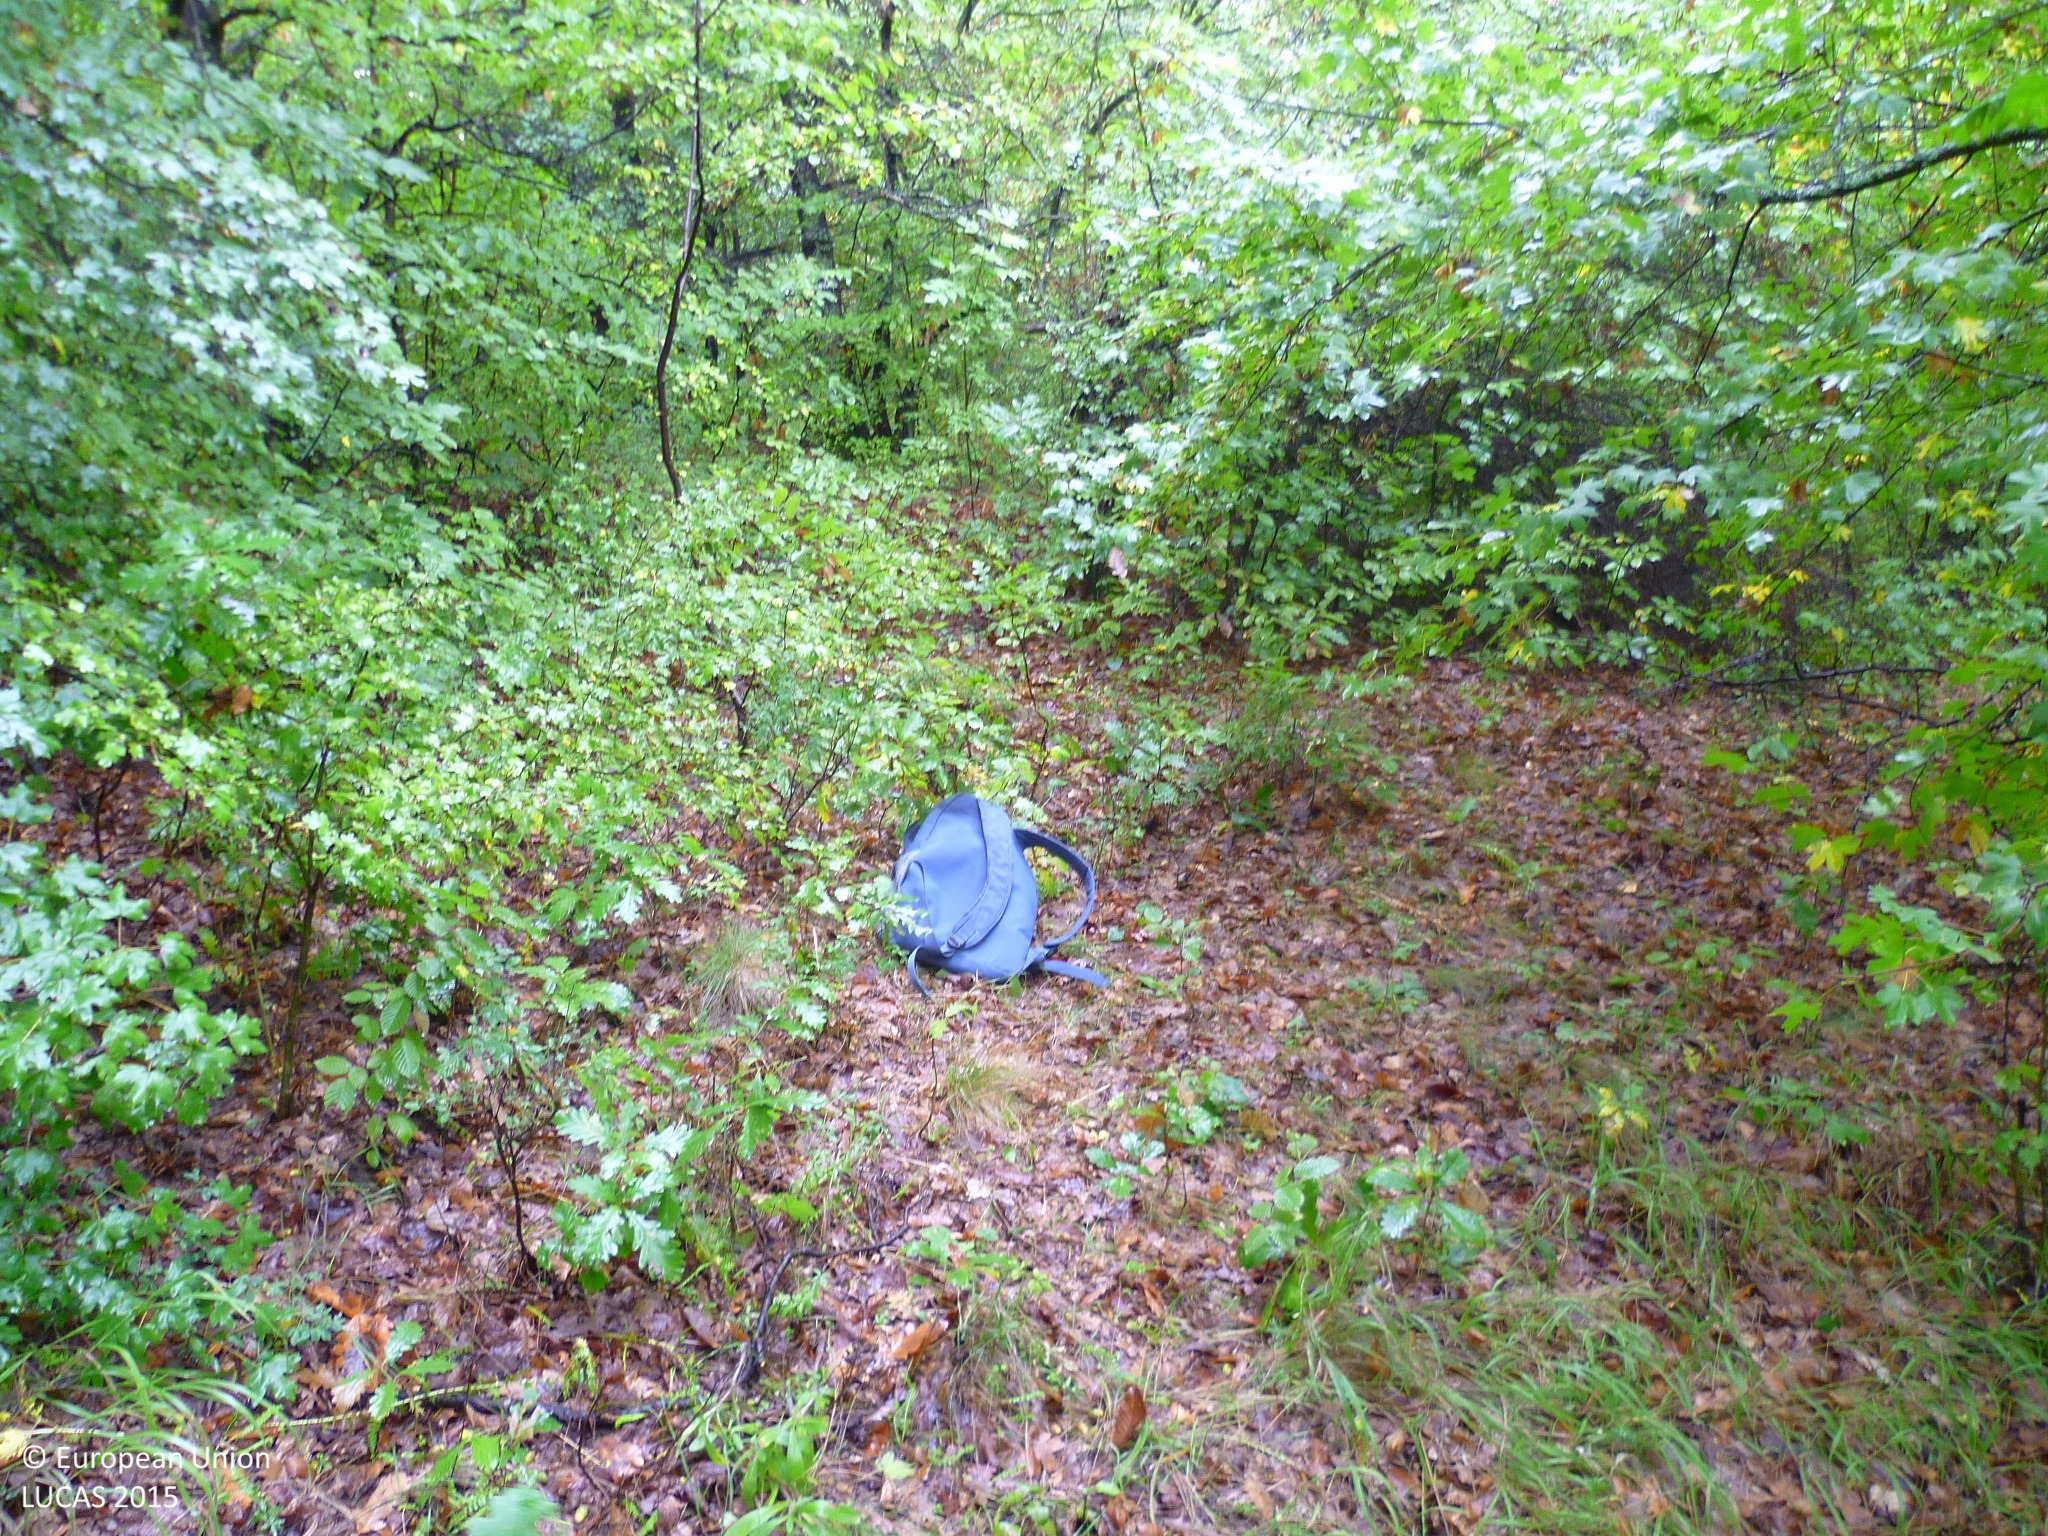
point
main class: Woodland
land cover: Broadleaved woodland
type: mesophytic deciduous forest
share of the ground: > 75 %
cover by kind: broadleaved forest trees 95 %, herbaceous plants 5 %
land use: Forestry
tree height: > 5 m
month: October
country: BG
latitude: 42.6361
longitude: 22.8440
